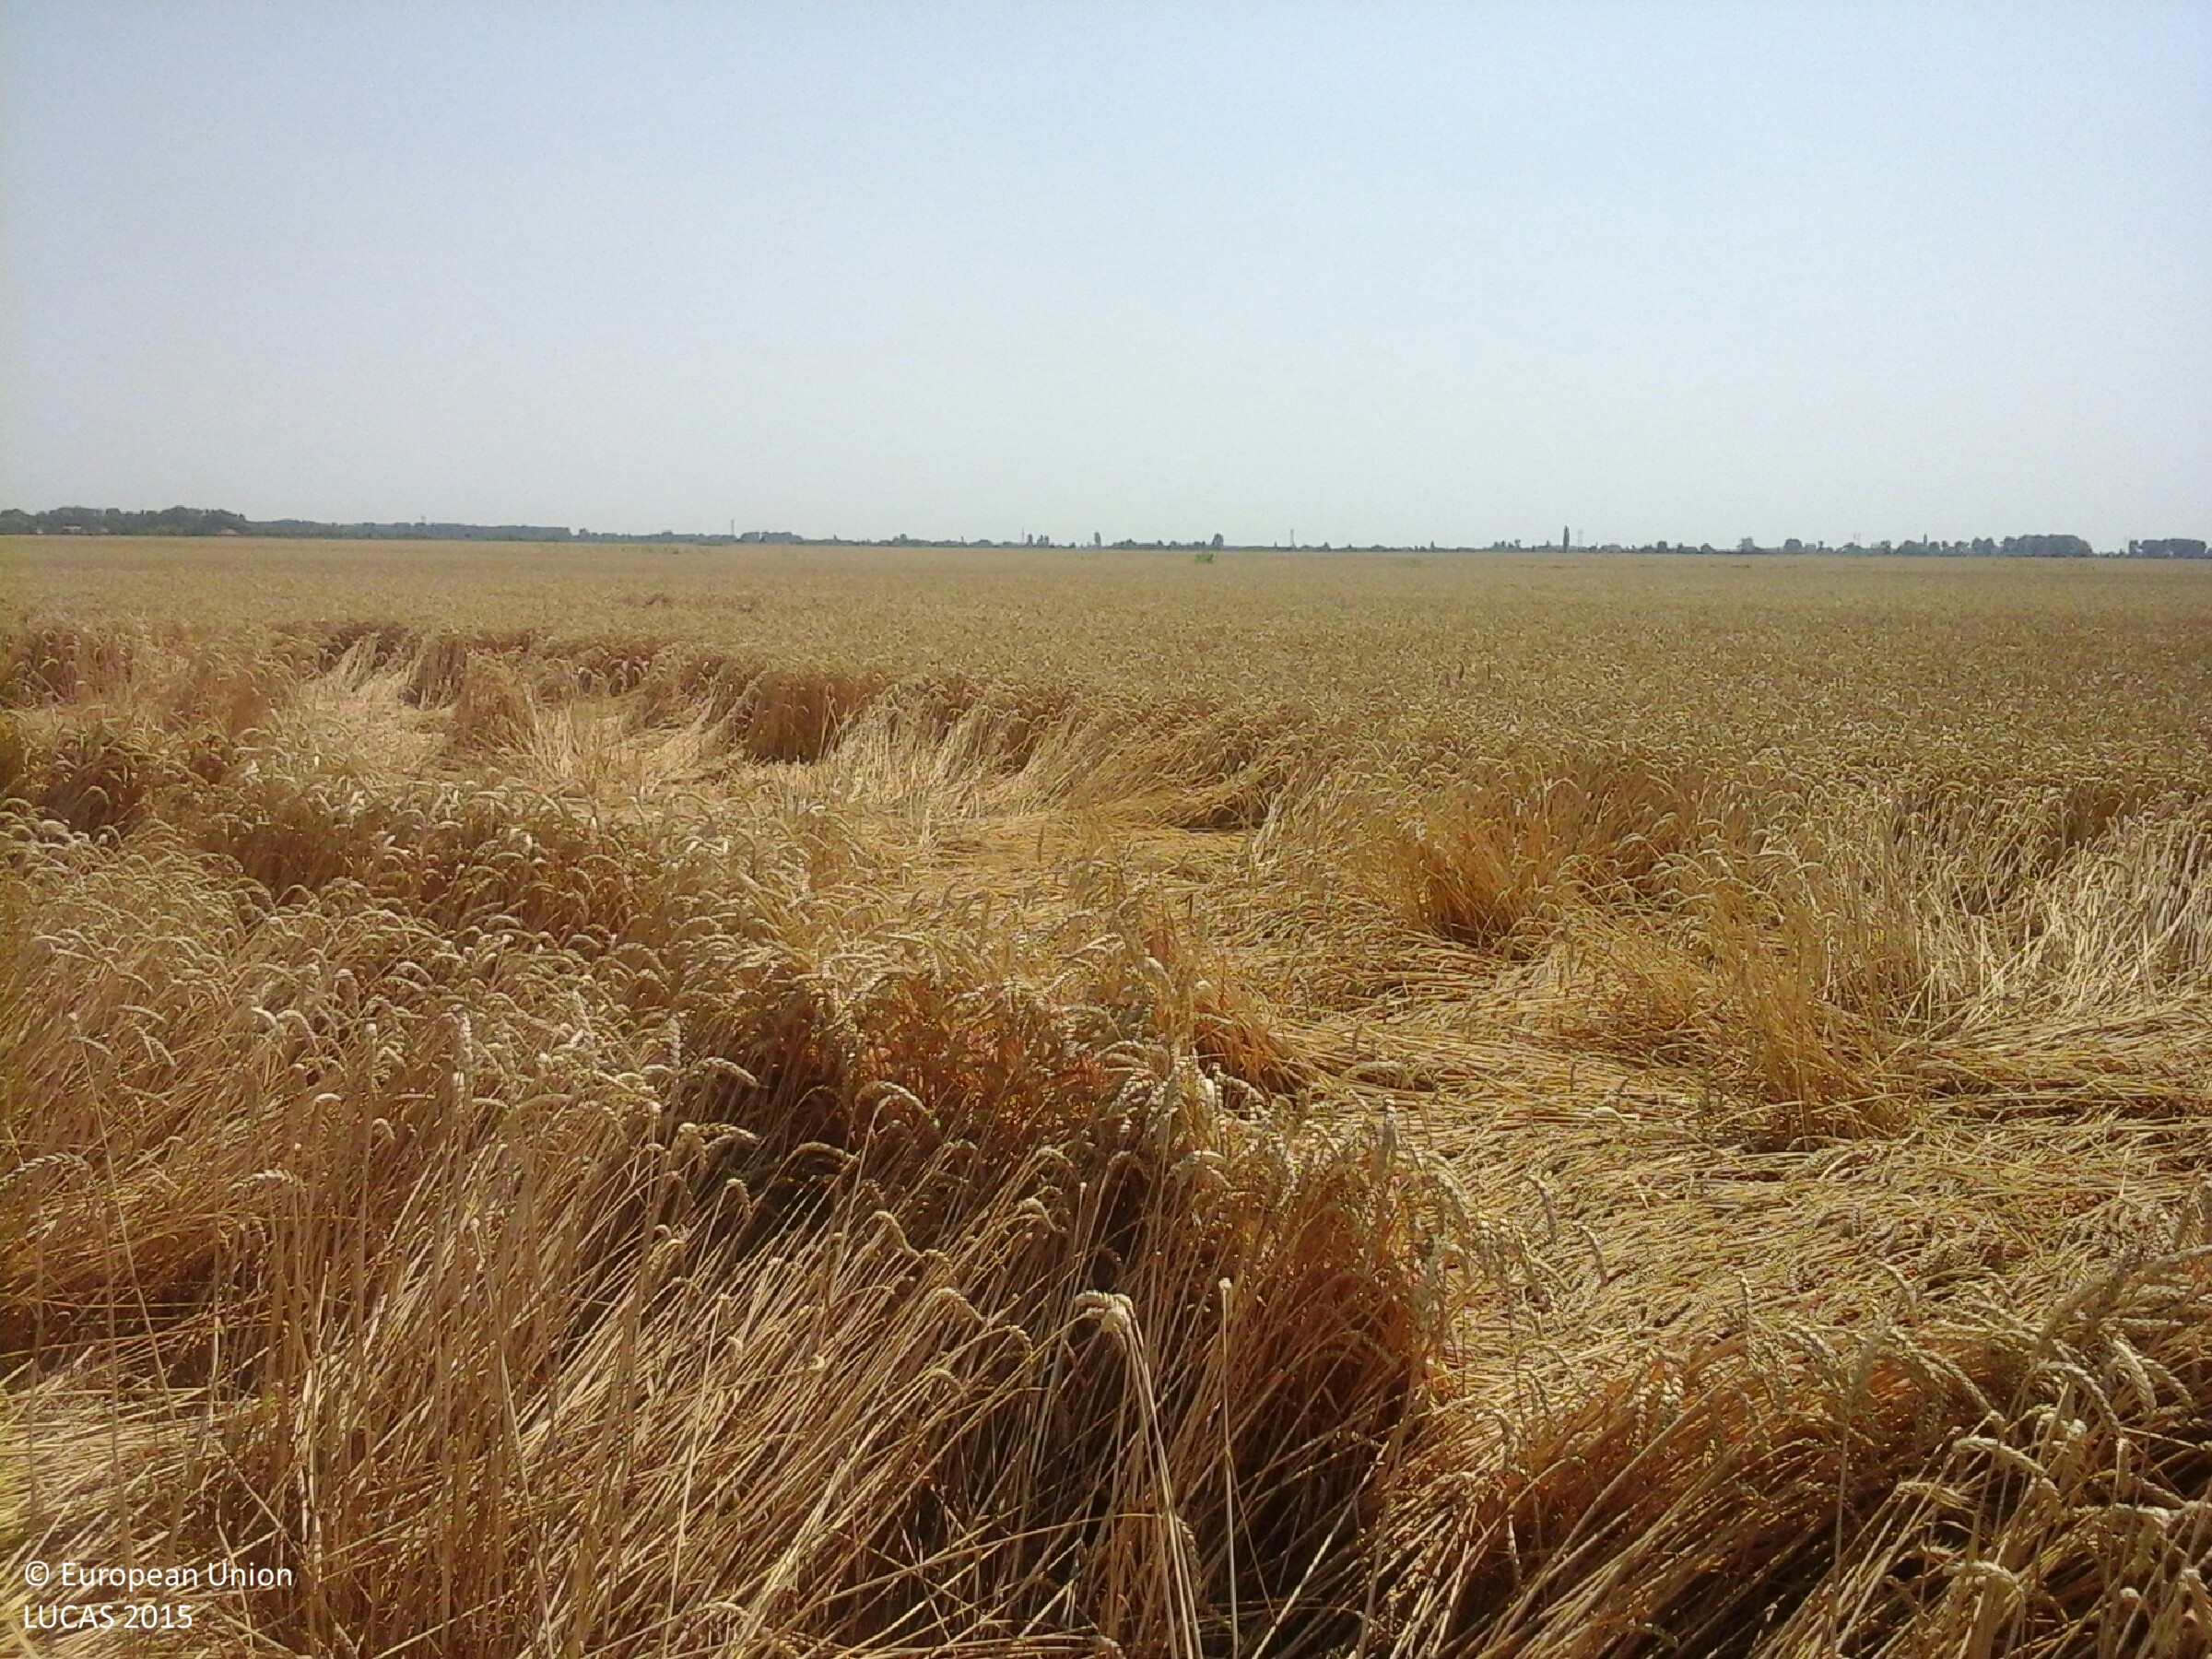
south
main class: Cropland
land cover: Common wheat
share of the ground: > 75 %
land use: Agriculture (excluding fallow land and kitchen gardens)
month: July
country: HU
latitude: 47.7566
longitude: 20.5042
